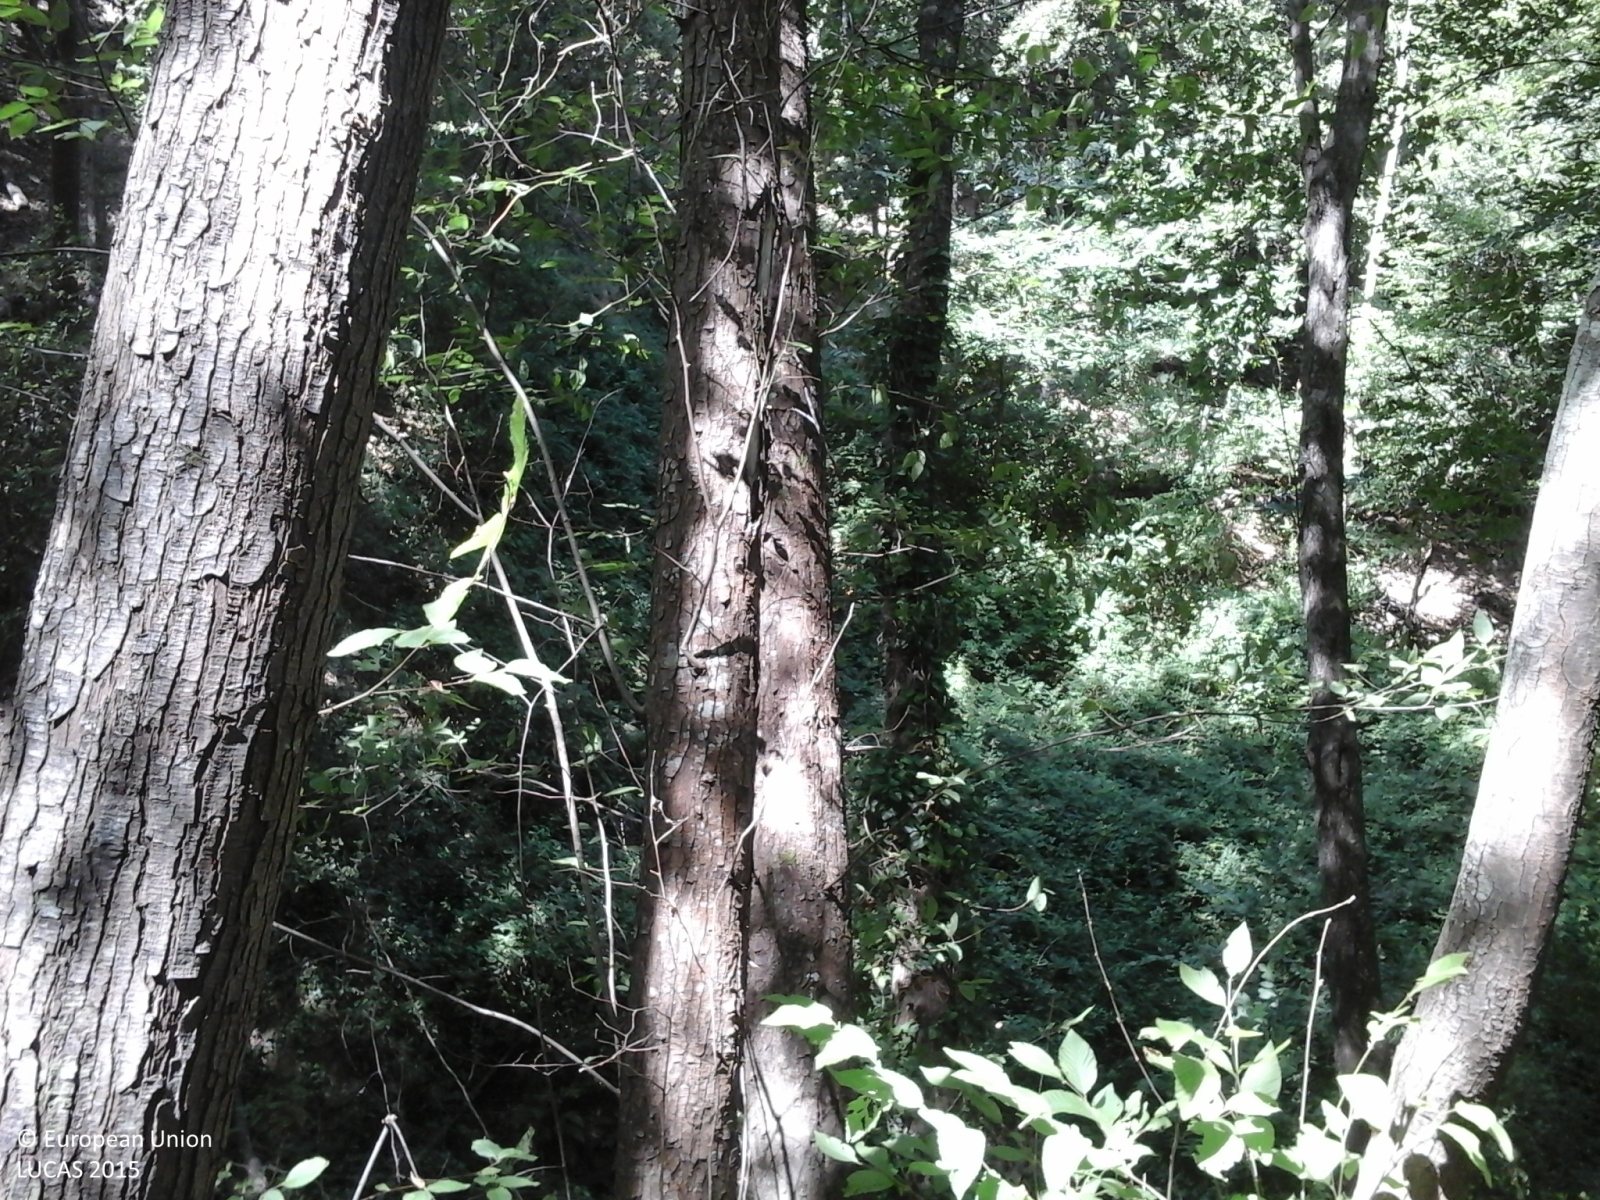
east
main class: Woodland
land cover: Other mixed woodland
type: broadleaved evergreen forest
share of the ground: > 75 %
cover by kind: broadleaved forest trees 75 %, coniferous forest trees 25 %
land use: Semi-natural and natural areas not in use
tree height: > 5 m
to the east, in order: Other mixed woodland; Tracks; Other mixed woodland
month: July
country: IT
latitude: 42.7801
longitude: 10.2802
